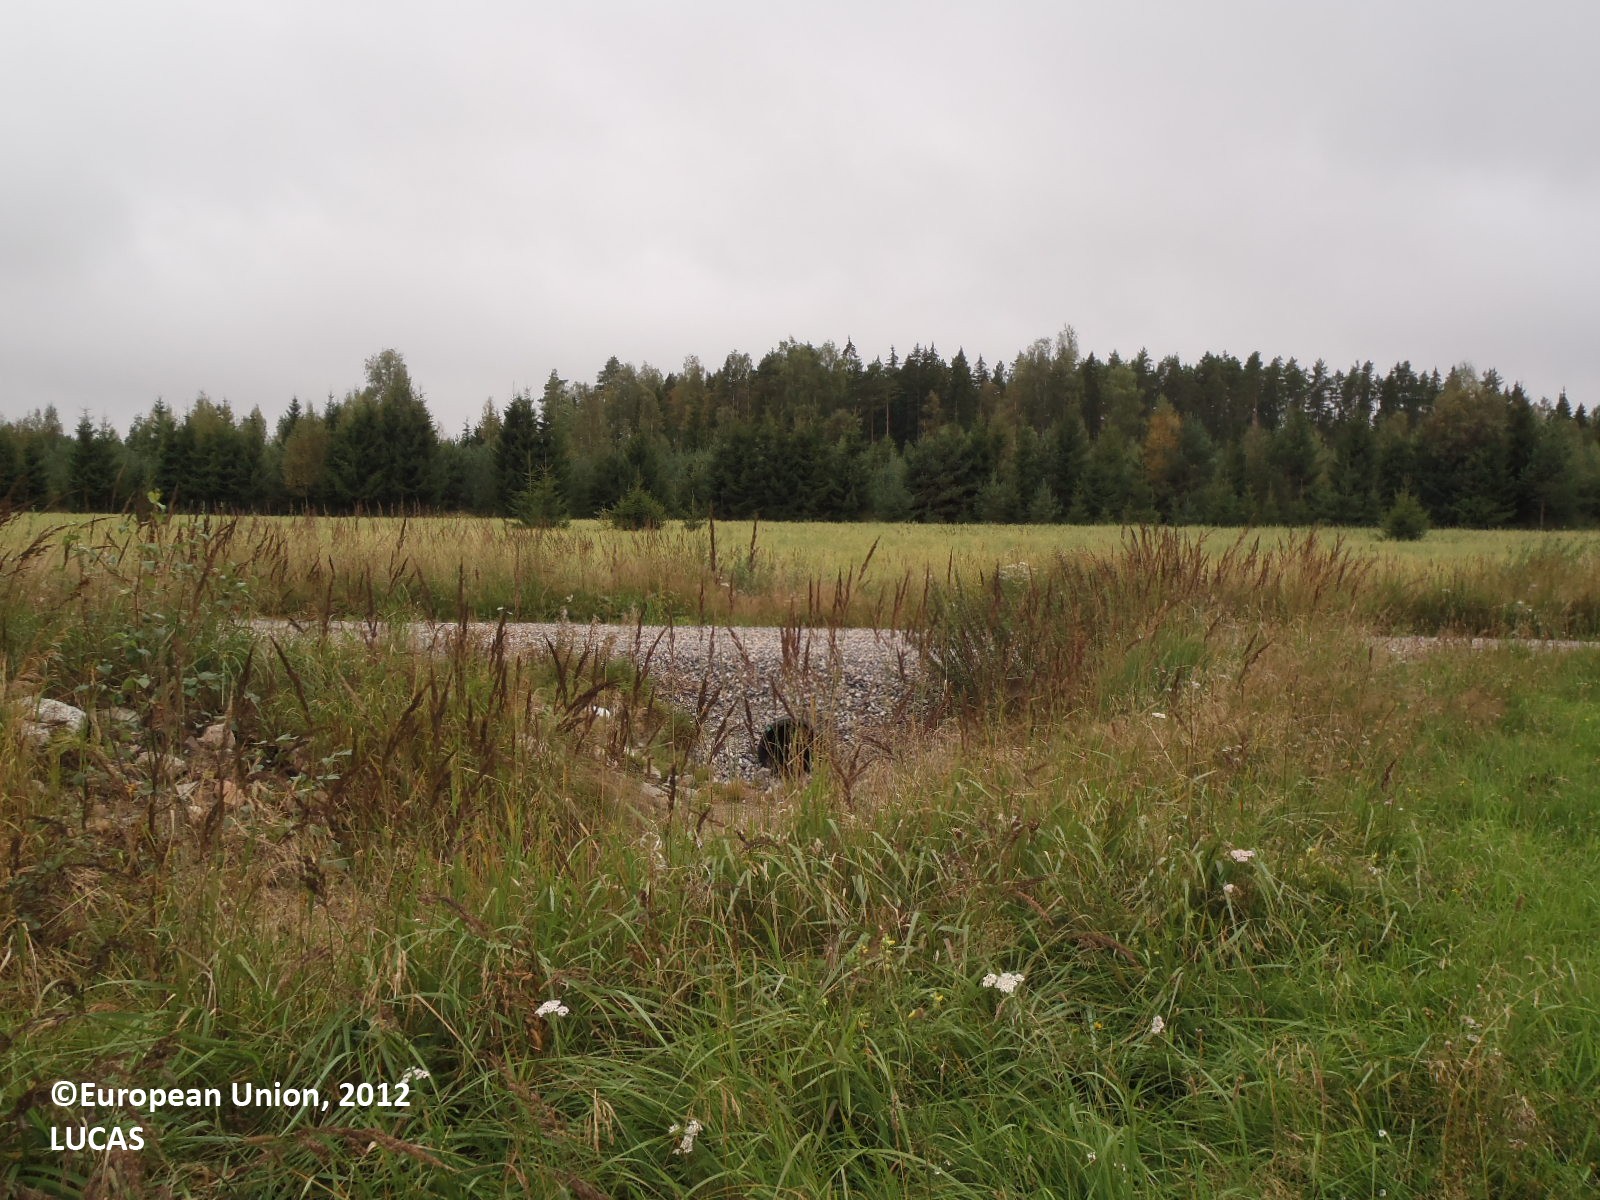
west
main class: Cropland
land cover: Rape and turnip rape
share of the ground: > 75 %
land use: Agriculture (excluding fallow land and kitchen gardens)
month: August
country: FI
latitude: 60.6501
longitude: 22.2282
